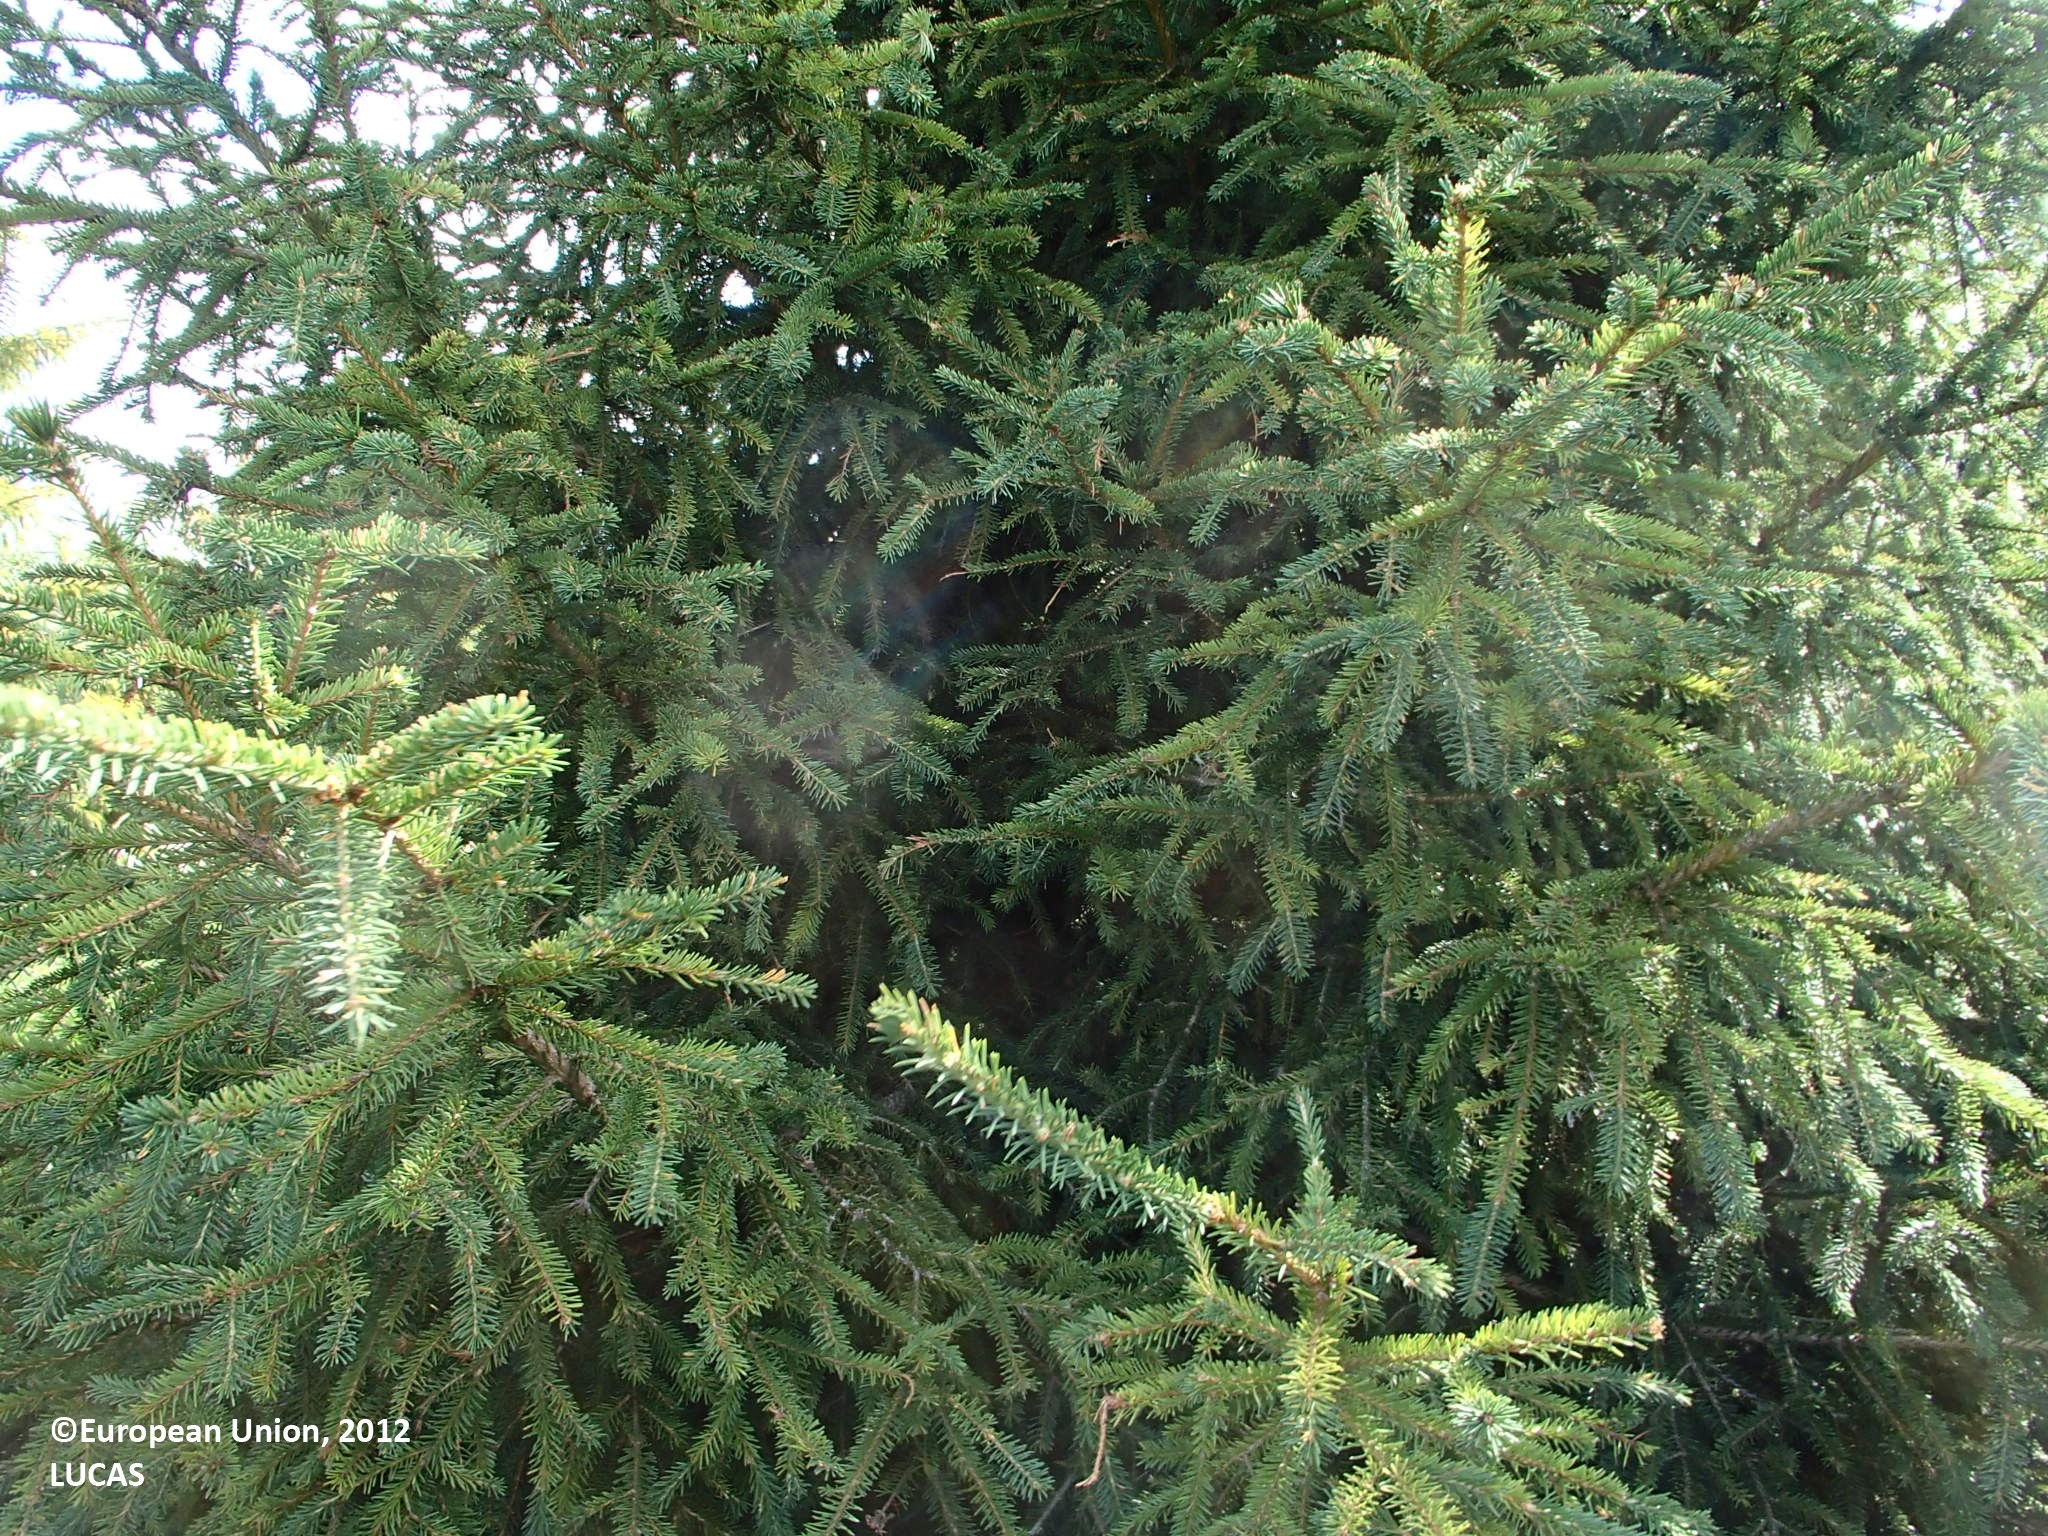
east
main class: Woodland
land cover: Spruce dominated coniferous woodland
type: boreal forest
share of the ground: 25 - 50 %
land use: Forestry
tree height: > 5 m
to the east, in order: Spruce dominated coniferous woodland; Other mixed woodland; Spruce dominated coniferous woodland; Other mixed woodland; Inland running water; Other mixed woodland
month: August
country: FI
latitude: 66.2372
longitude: 25.5249
